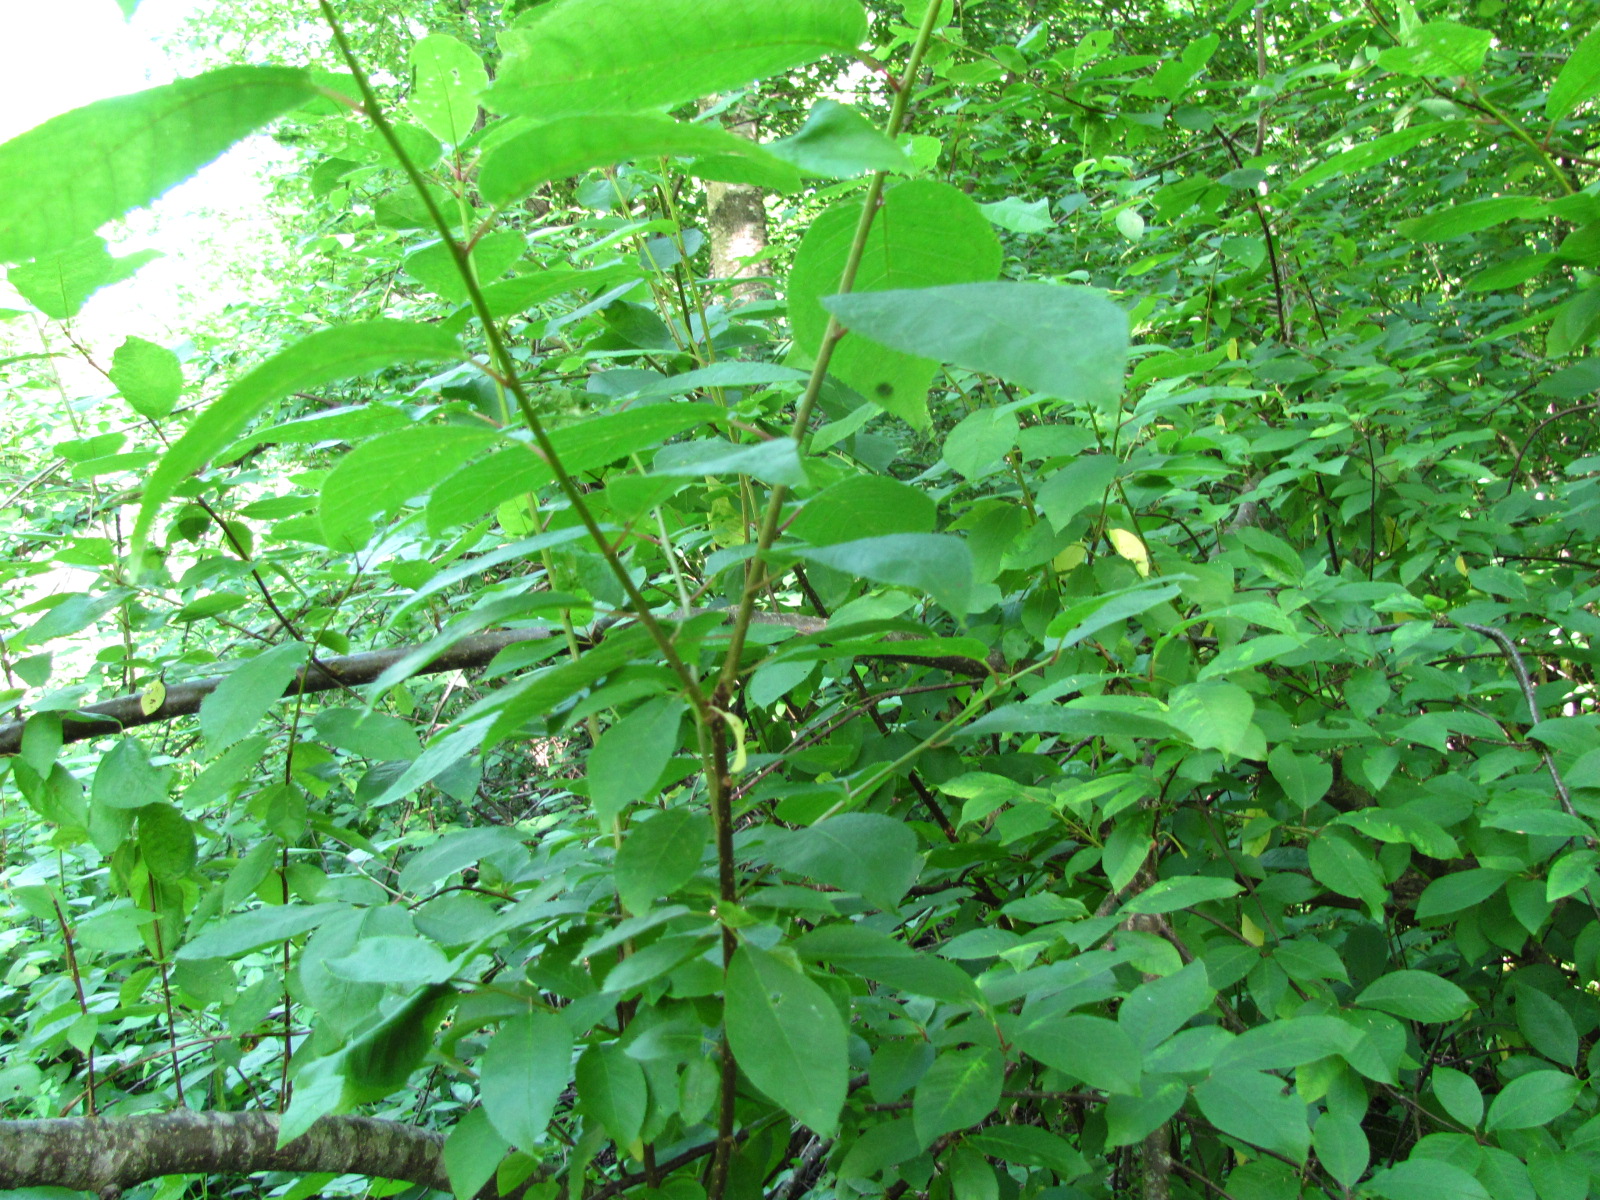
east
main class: Woodland
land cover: Broadleaved woodland
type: non-riverine alder, birch or aspen forest
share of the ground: > 75 %
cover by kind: broadleaved forest trees 100 %
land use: Forestry
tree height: > 5 m
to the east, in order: Broadleaved woodland
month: June
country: LV
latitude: 56.4861
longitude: 24.2347
